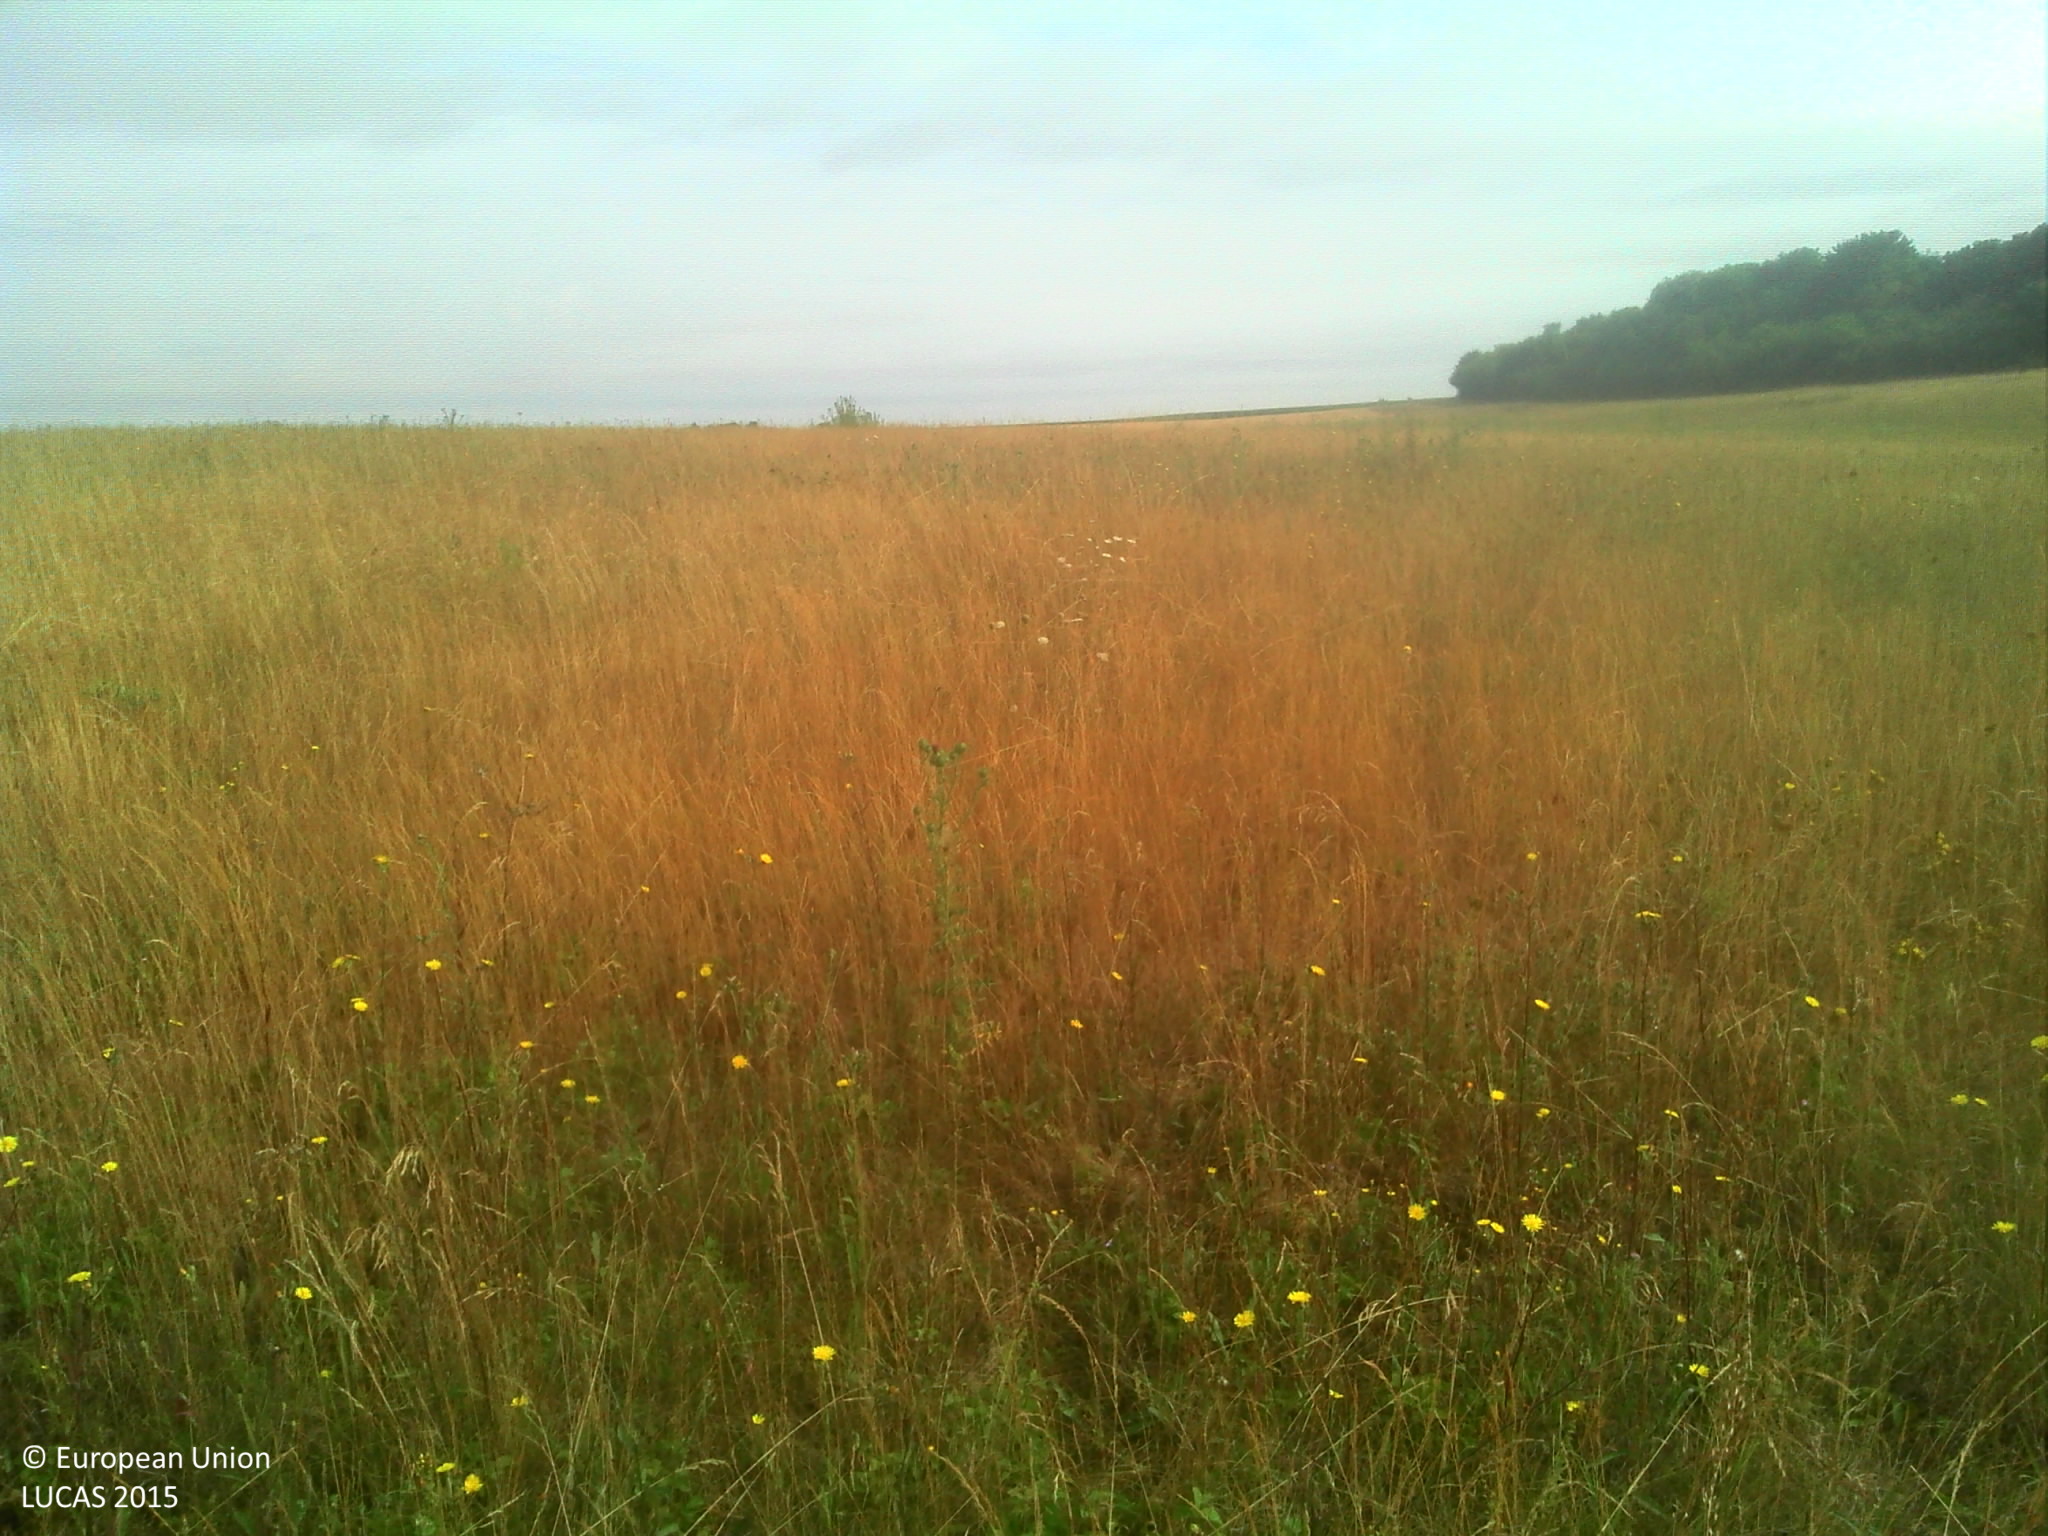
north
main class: Grassland
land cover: Grassland without tree/shrub cover
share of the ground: > 75 %
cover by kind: herbaceous plants 100 %
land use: Agriculture (excluding fallow land and kitchen gardens)
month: July
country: FR
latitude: 47.7923
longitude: 1.3471
